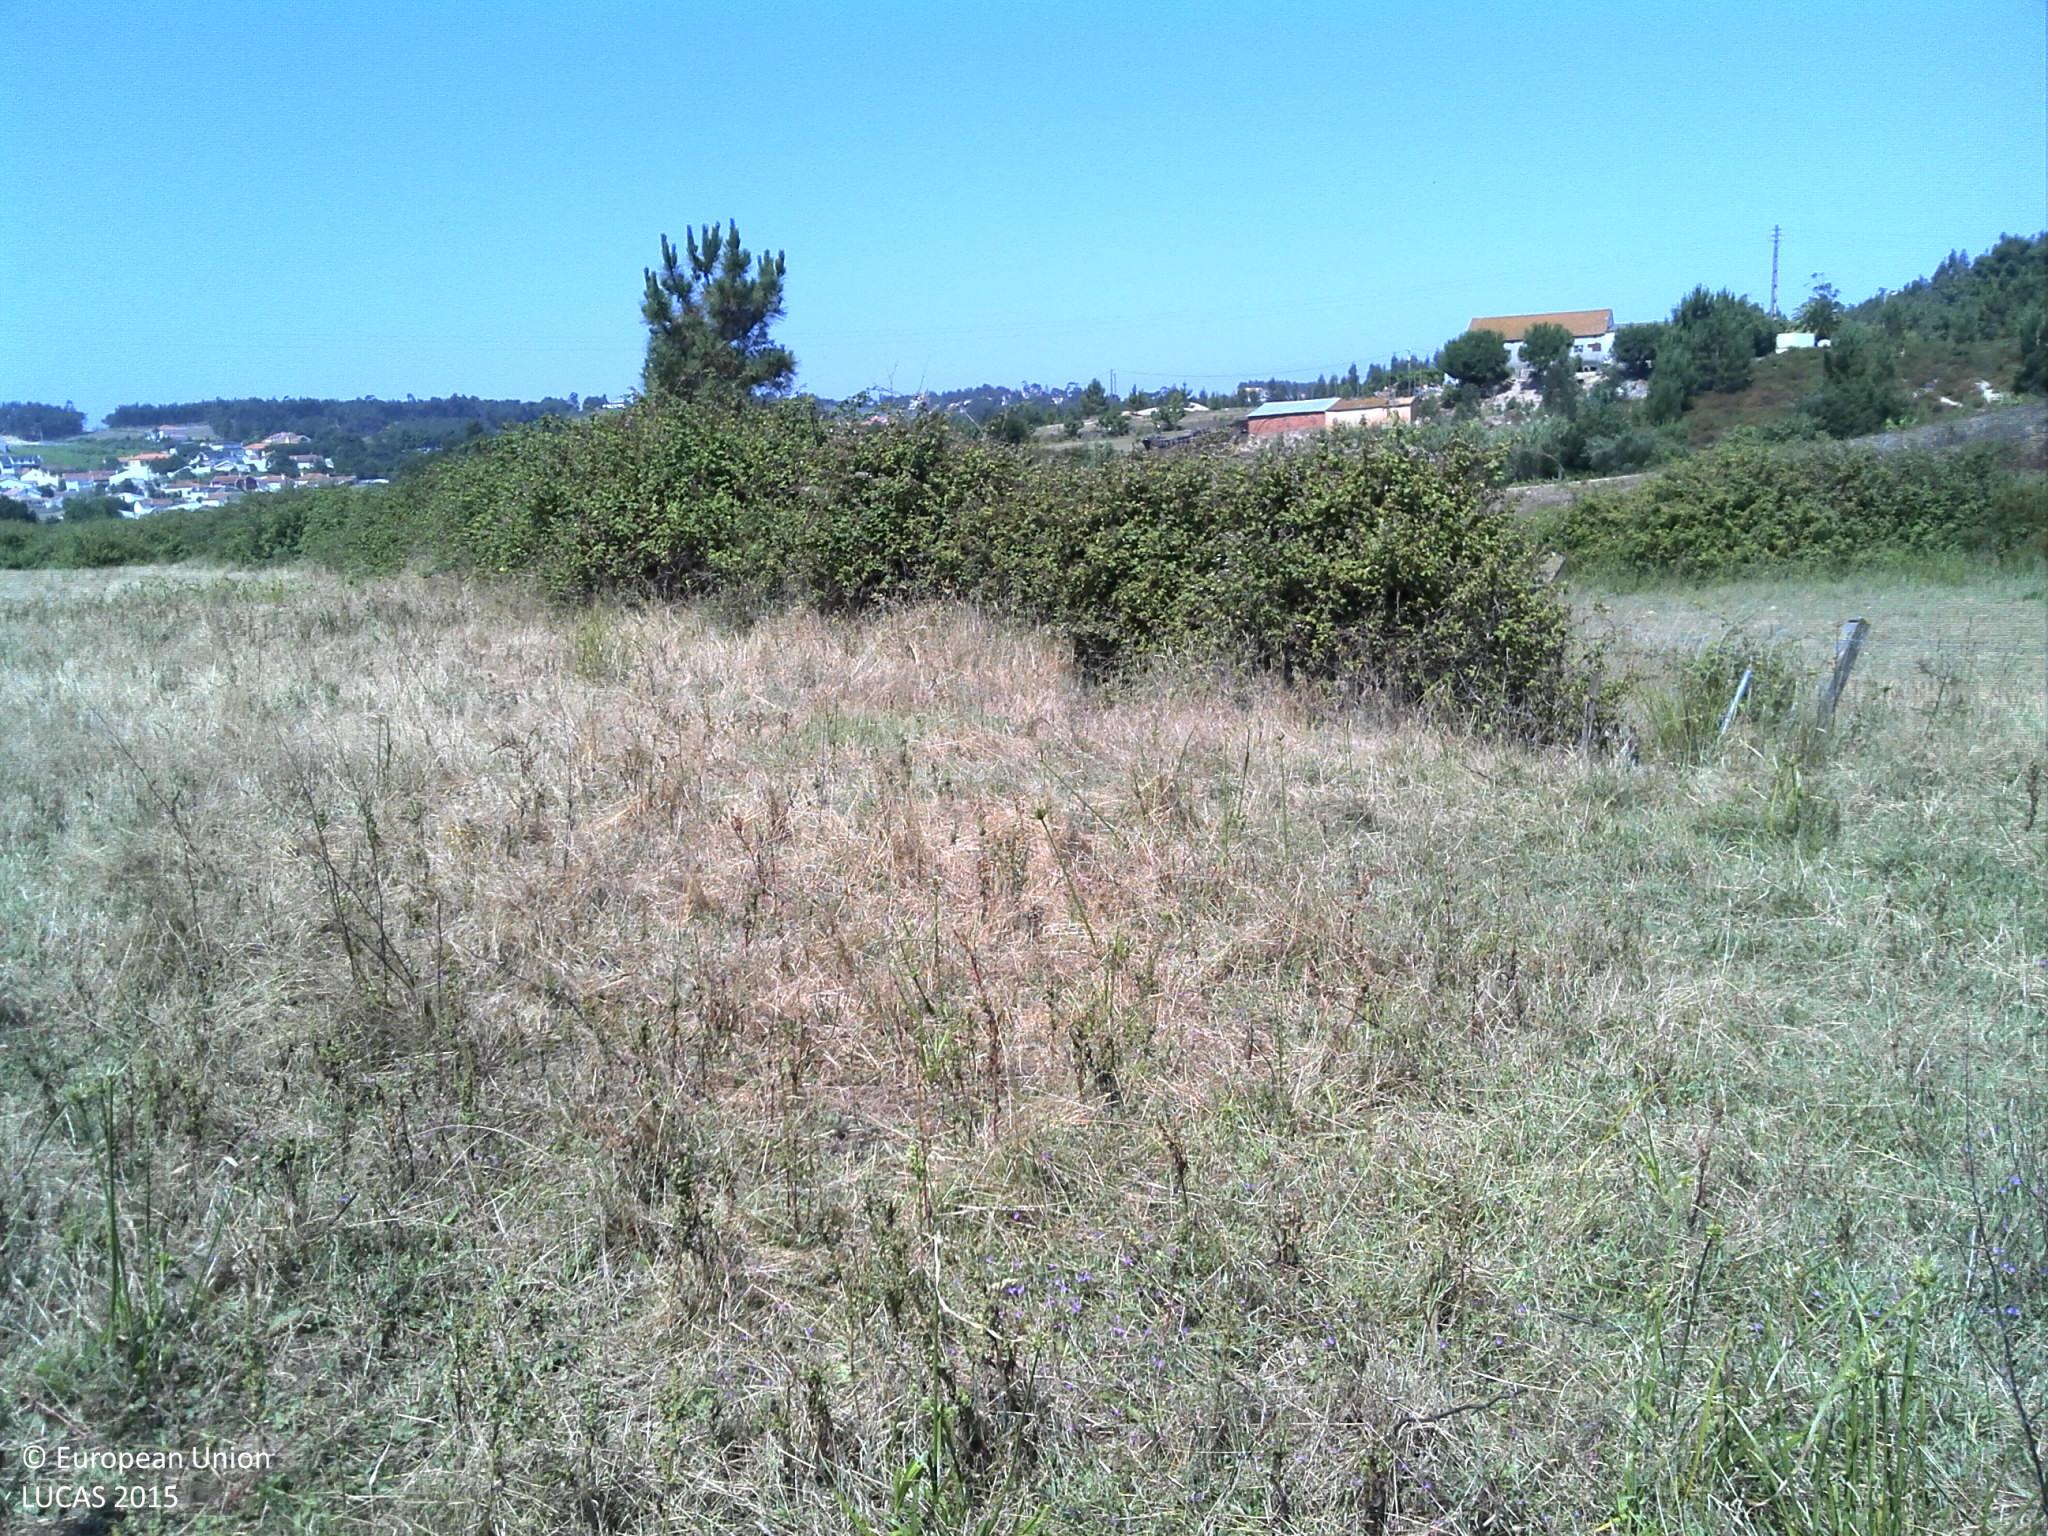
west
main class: Grassland
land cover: Grassland without tree/shrub cover
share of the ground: 50 - 75 %
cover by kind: herbaceous plants 55 %, unconsolidated bare surface 40 %, shrubs 5 %
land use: Agriculture (excluding fallow land and kitchen gardens)
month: June
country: PT
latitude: 39.1097
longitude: -9.2965
